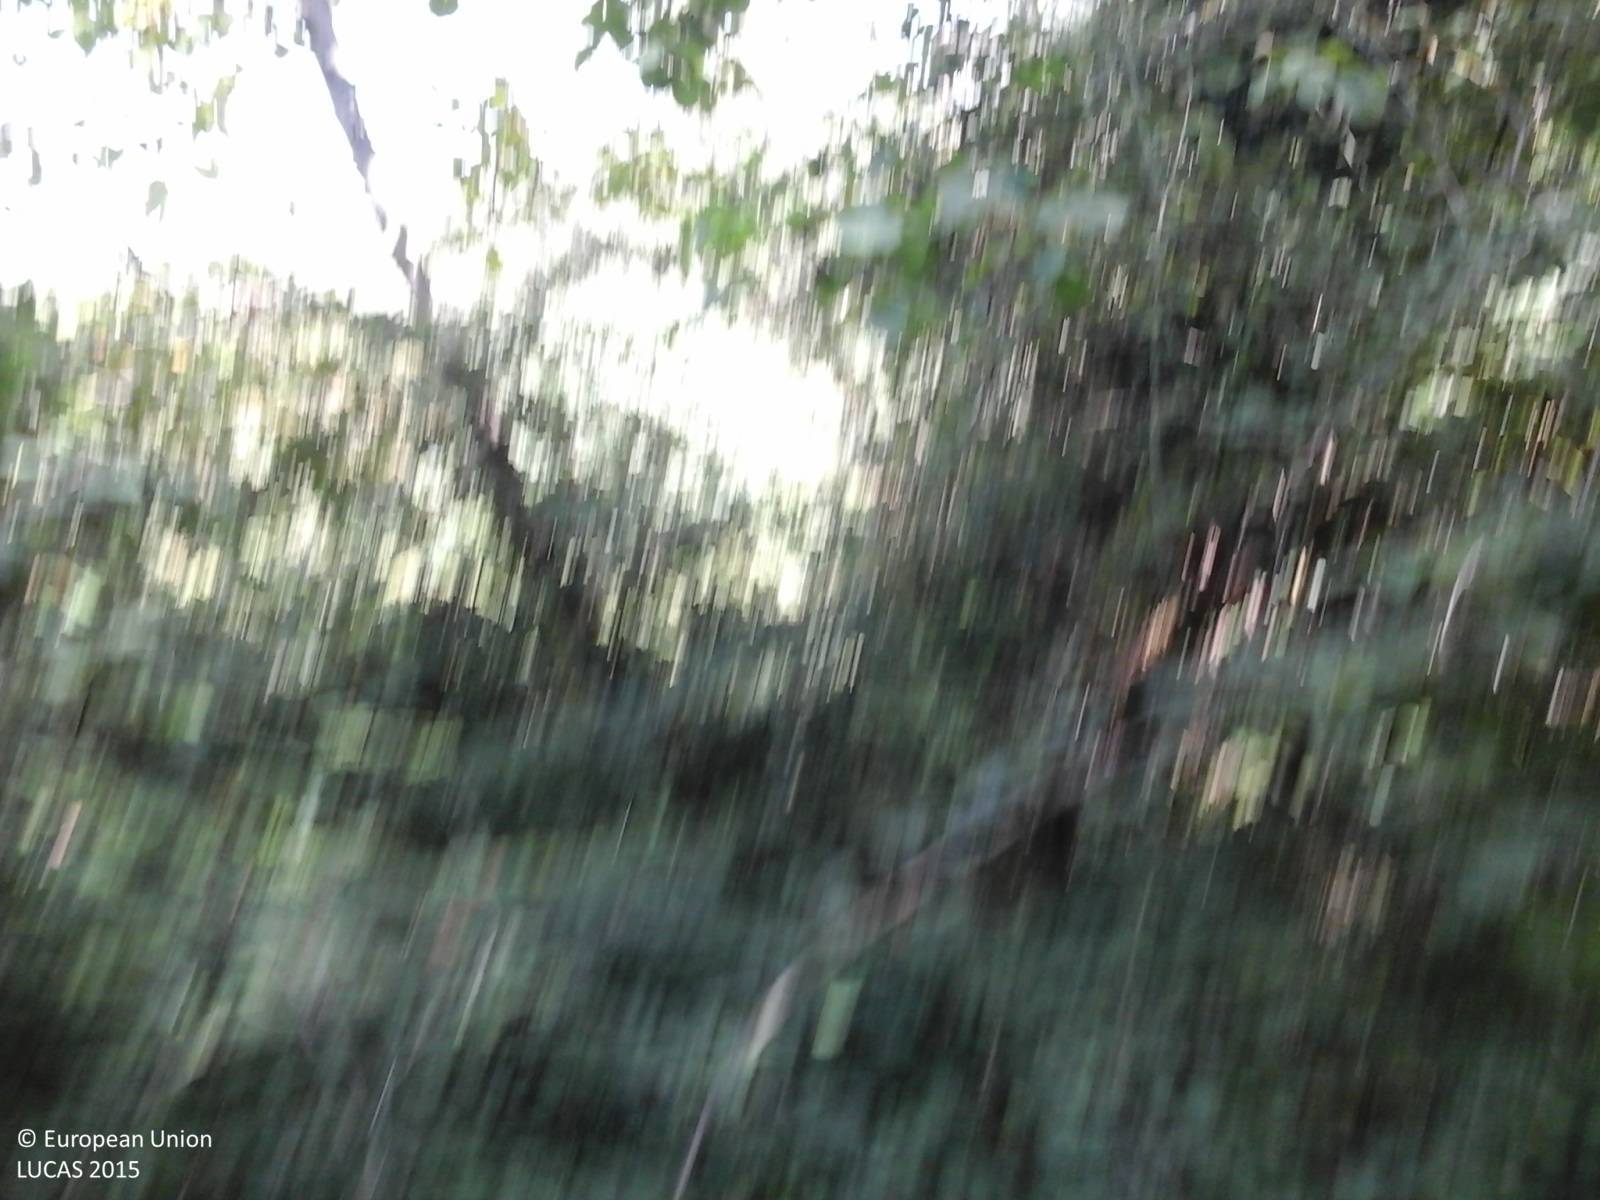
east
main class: Woodland
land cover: Broadleaved woodland
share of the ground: 50 - 75 %
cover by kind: broadleaved forest trees 70 %, shrubs 30 %
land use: Forestry
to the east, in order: Broadleaved woodland; Rivers and streams; Broadleaved woodland; Other fruit trees and berries; Electric lines; Other fruit trees and berries; Olive groves; Dry stone walls; Olive groves; Dry stone walls; Olive groves; Artificial constructions in urban areas; Olive groves; Electric lines; Olive groves; Vineyards; Olive groves; Electric lines; Olive groves
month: September
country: IT
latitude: 43.0298
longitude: 12.0924
